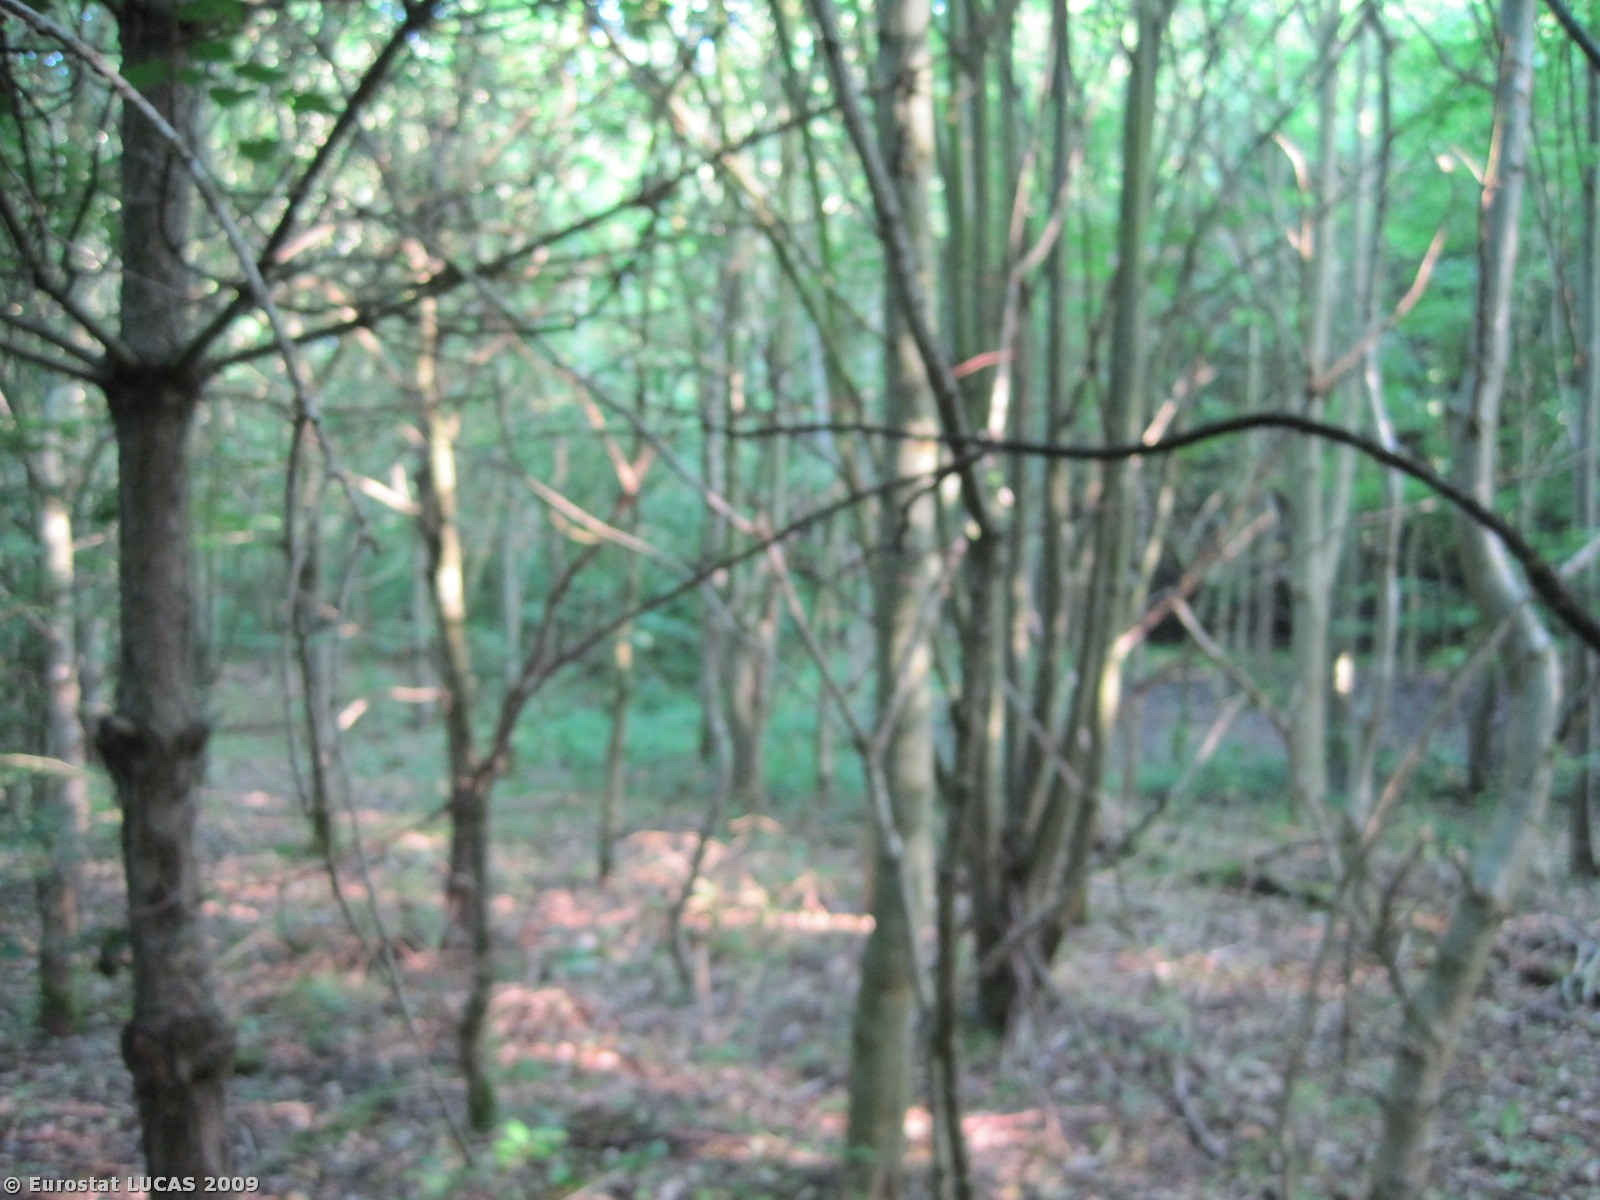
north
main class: Woodland
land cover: Broadleaved woodland
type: plantations and self-sown exotic forest
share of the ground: > 75 %
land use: Unused
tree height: > 5 m
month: July
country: DK
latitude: 56.3747
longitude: 8.3342
